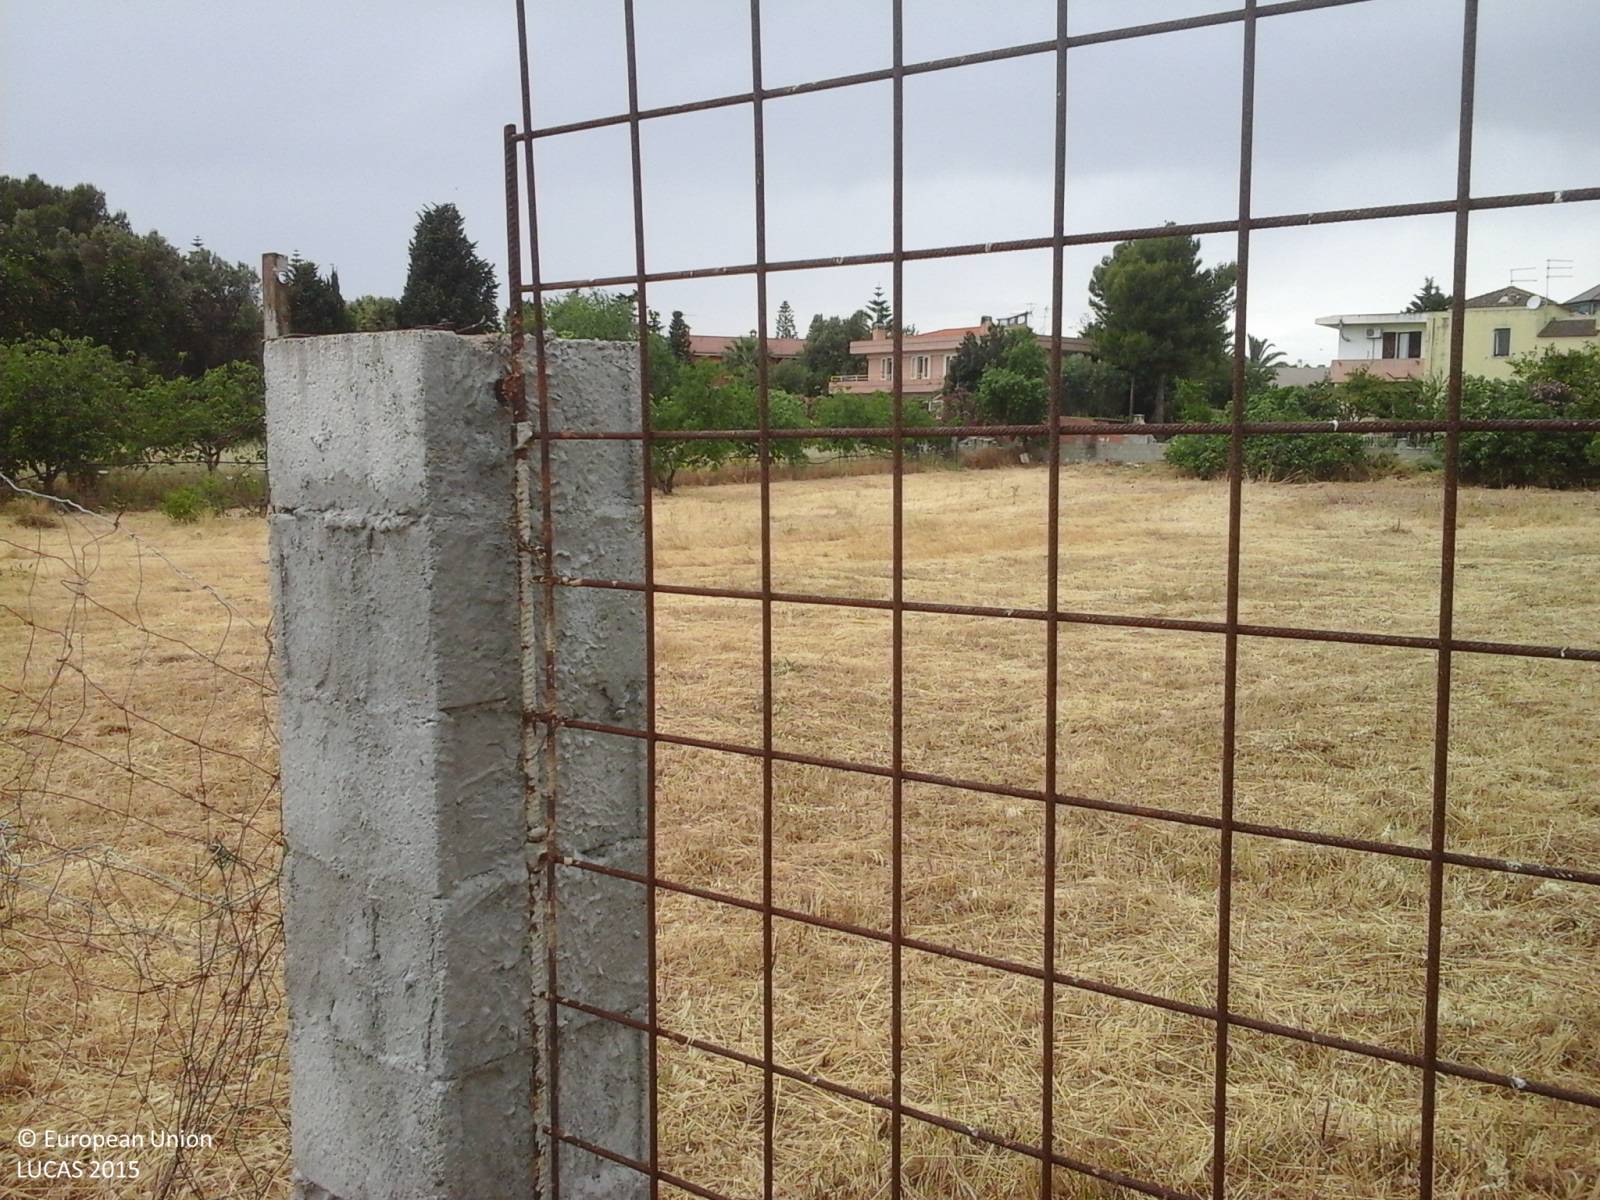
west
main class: Cropland
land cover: Mixed cereals for fodder
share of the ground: > 75 %
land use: Agriculture (excluding fallow land and kitchen gardens)
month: May
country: IT
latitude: 39.2319
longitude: 9.2286
